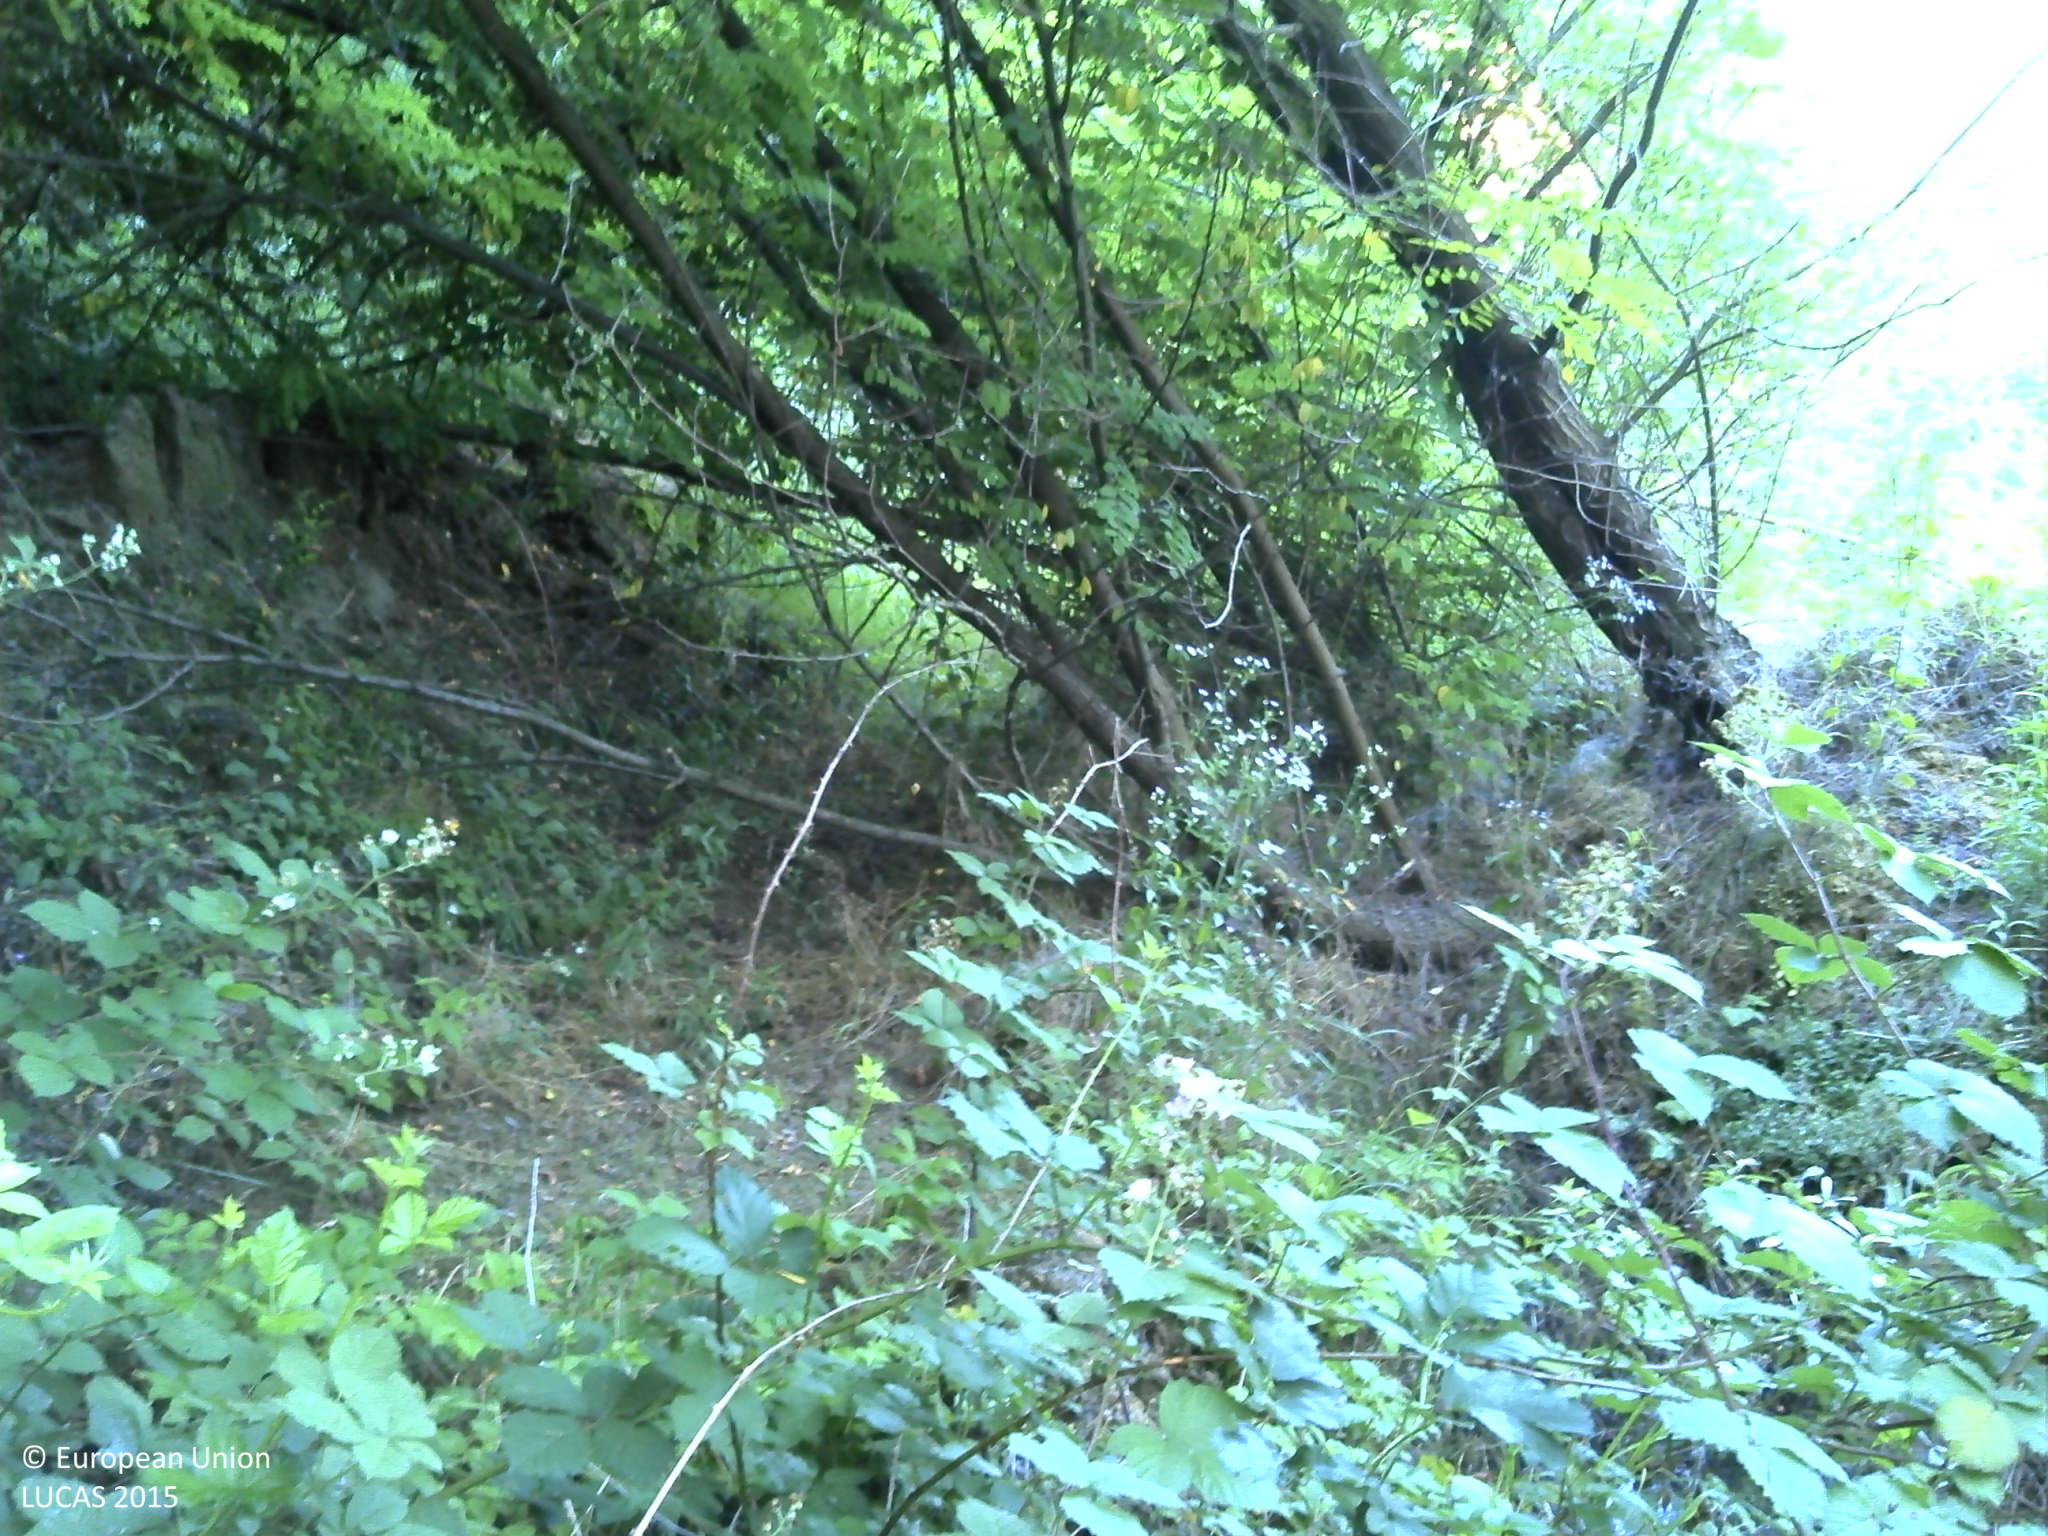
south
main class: Woodland
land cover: Broadleaved woodland
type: acidophilous oak and oak-birch forest
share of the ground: > 75 %
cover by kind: broadleaved forest trees 90 %, shrubs 10 %
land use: Forestry
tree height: < 5 m
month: June
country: HR
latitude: 45.8303
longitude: 17.3010
